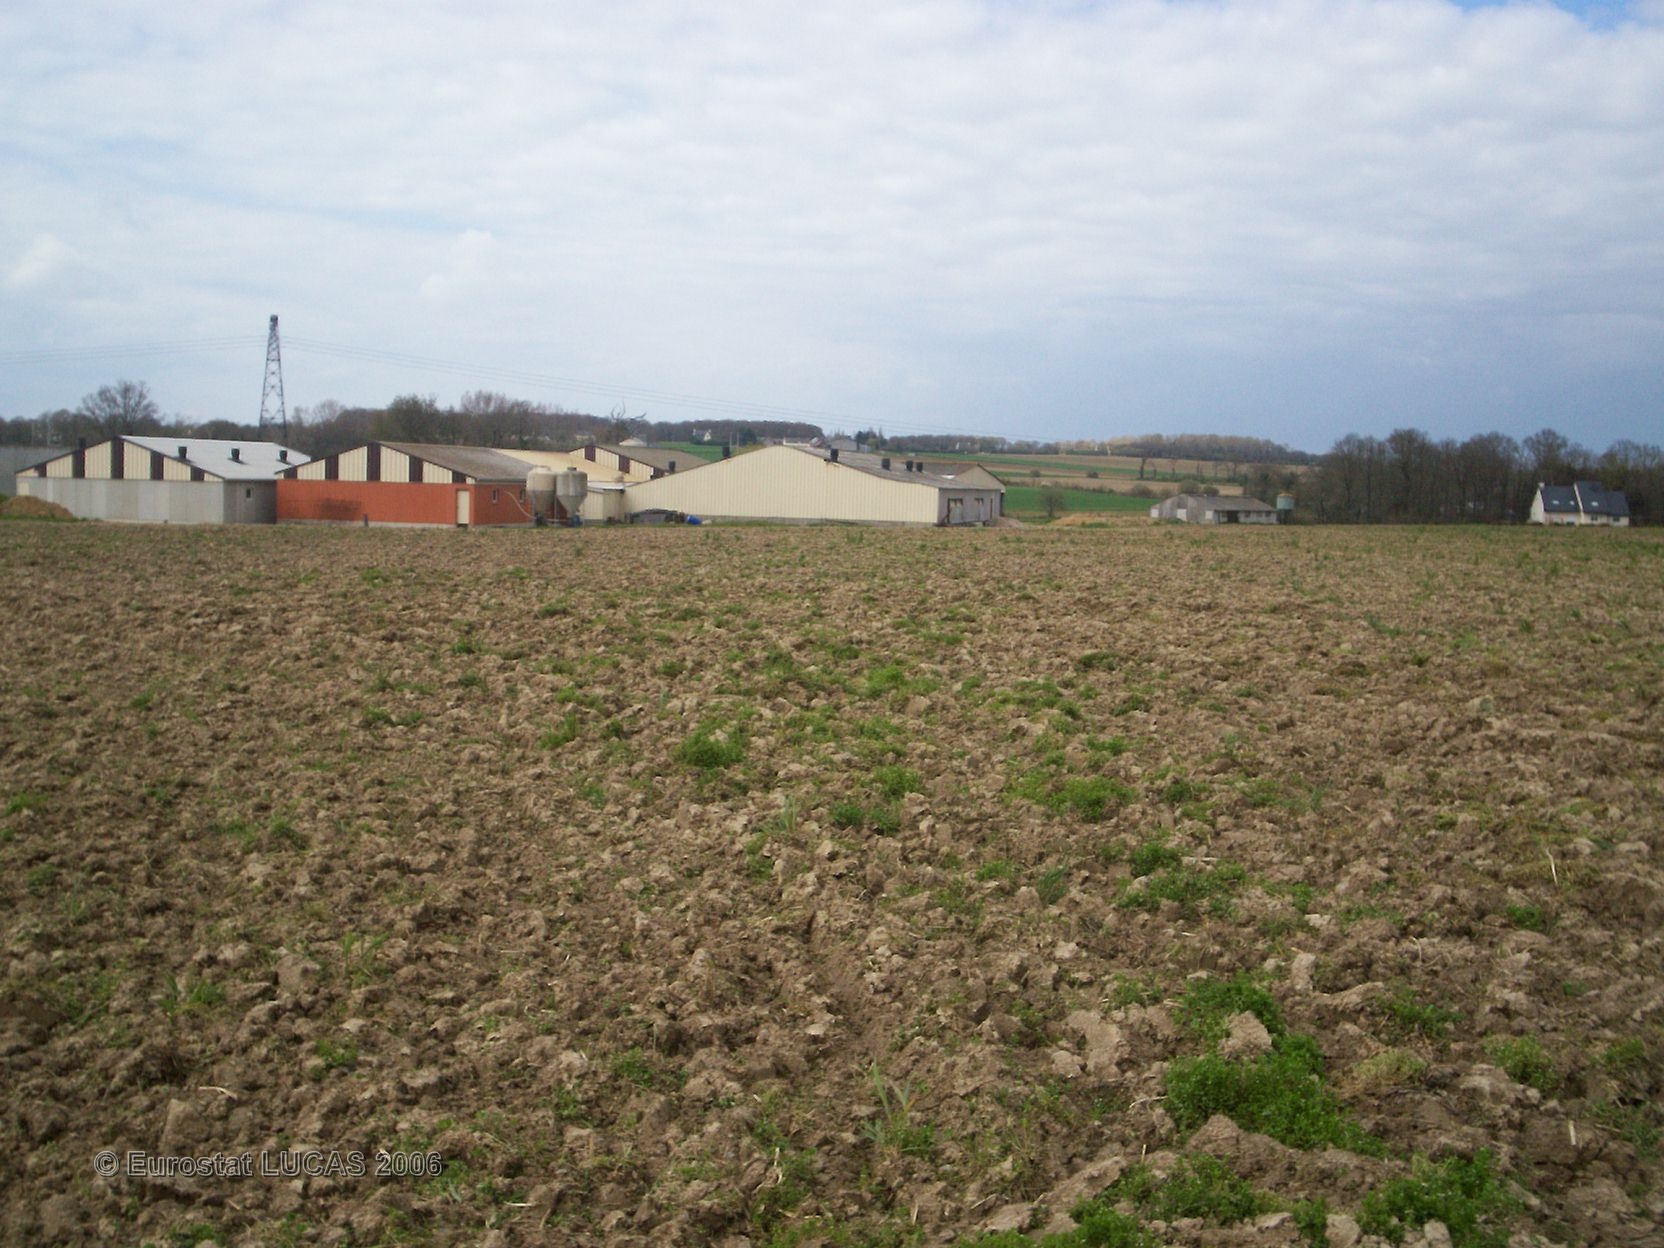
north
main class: Cropland
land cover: Maize
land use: Agriculture (excluding fallow land and kitchen gardens)
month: June
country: FR
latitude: 48.4892
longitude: -2.5239
